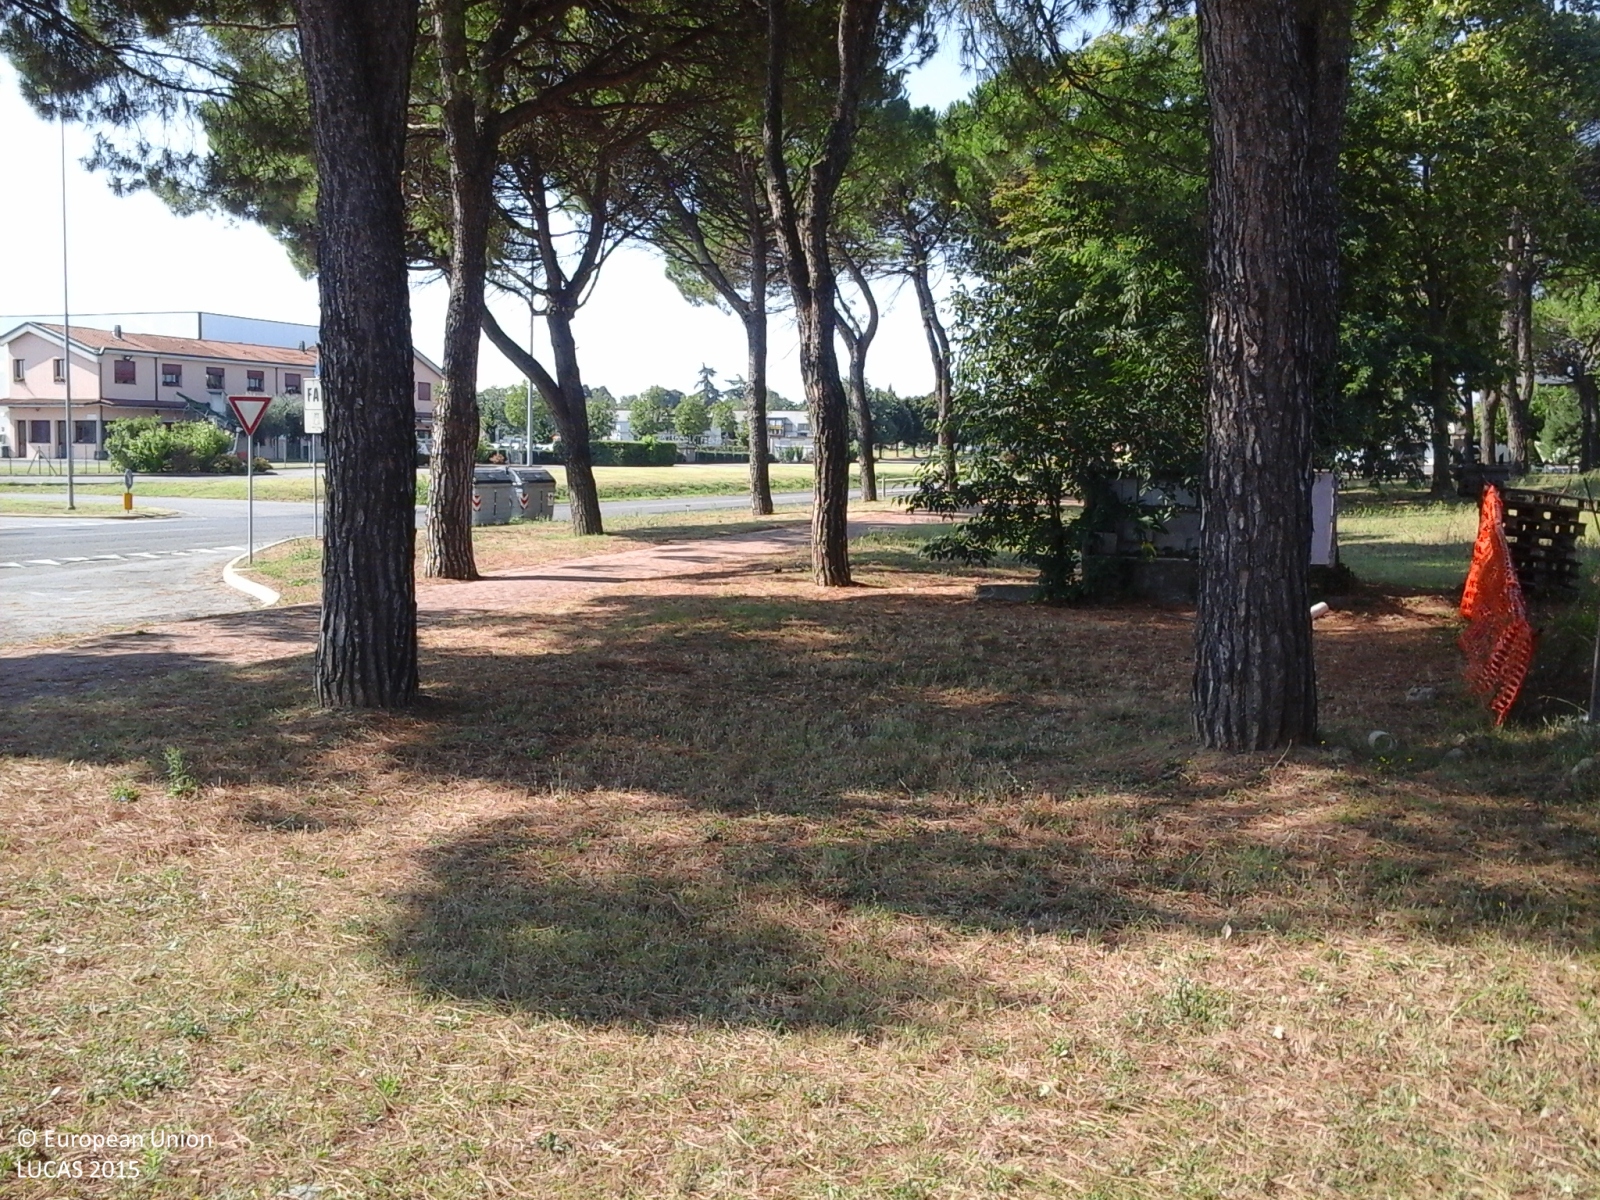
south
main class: Woodland
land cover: Pine dominated coniferous woodland
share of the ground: > 75 %
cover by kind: coniferous forest trees 75 %, herbaceous plants 25 %
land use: Amenities, museums, leisure
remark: Clear cut
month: August
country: IT
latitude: 44.2788
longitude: 11.9128
